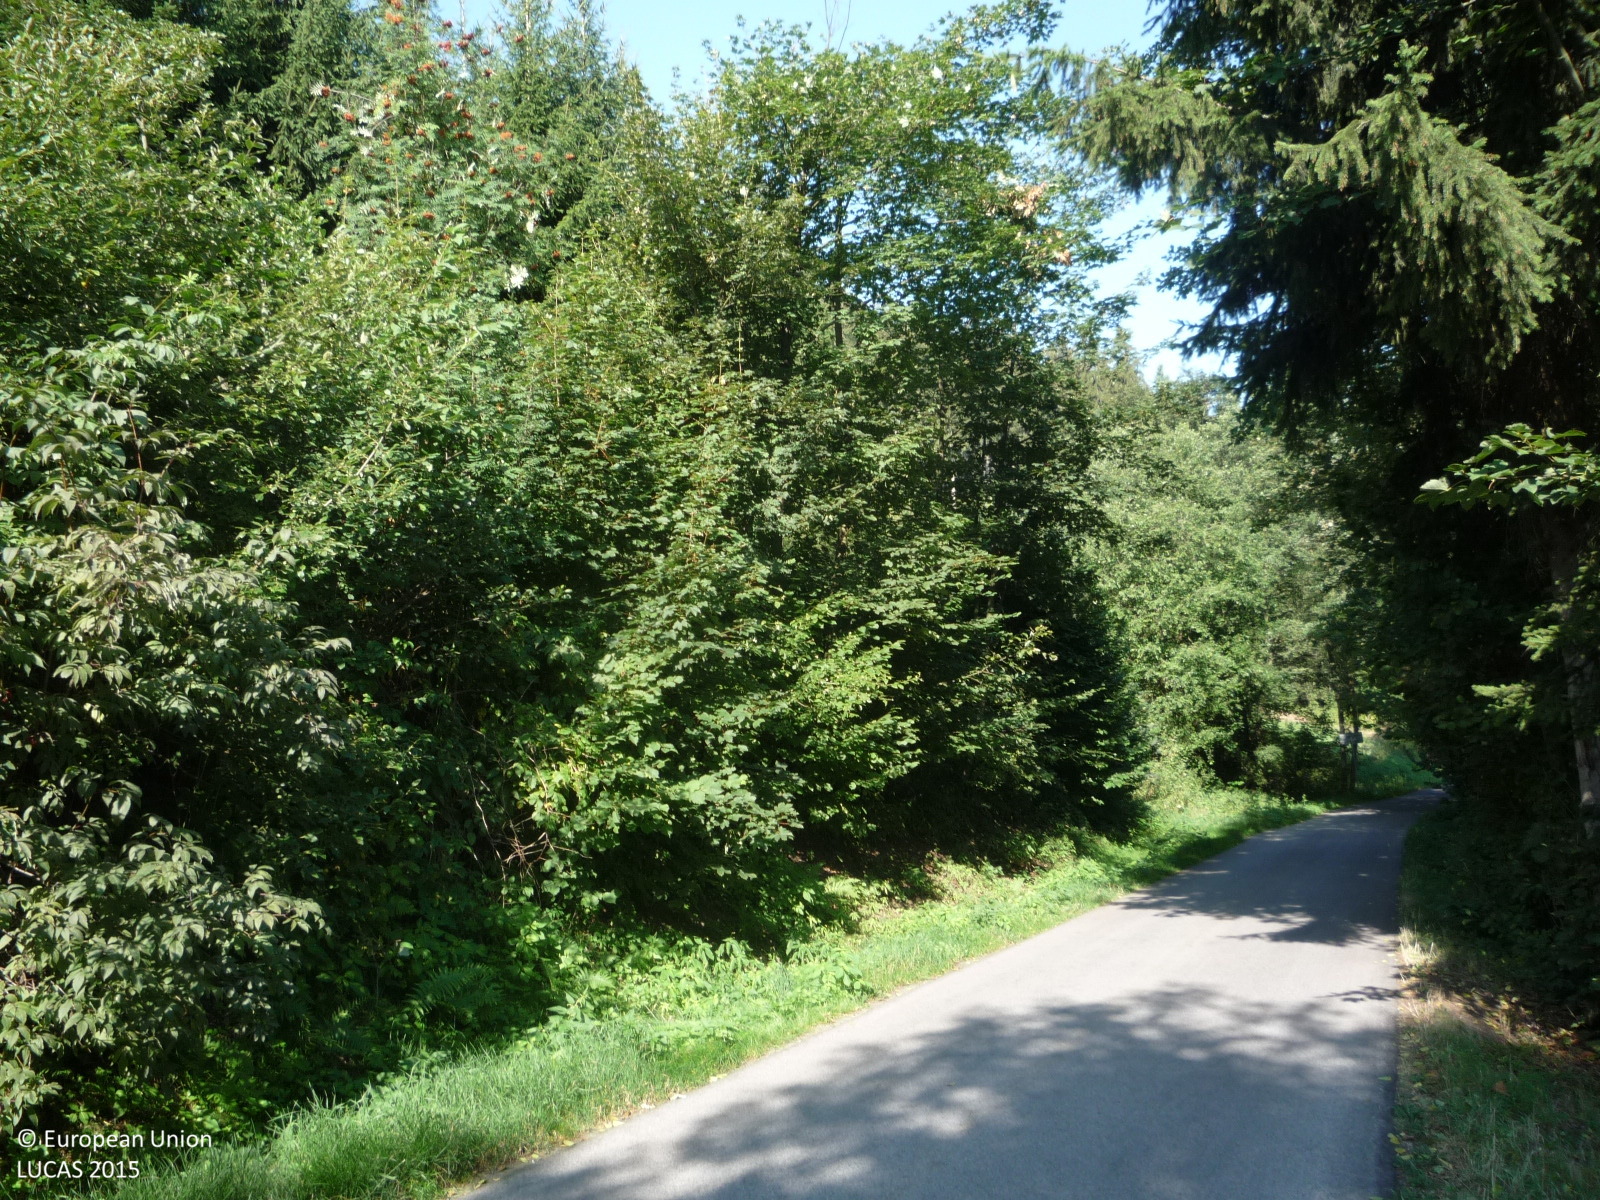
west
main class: Woodland
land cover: Broadleaved woodland
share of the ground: > 75 %
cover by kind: broadleaved forest trees 85 %, herbaceous plants 10 %, shrubs 5 %
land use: Semi-natural and natural areas not in use
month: August
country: CZ
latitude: 50.6221
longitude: 15.2475
